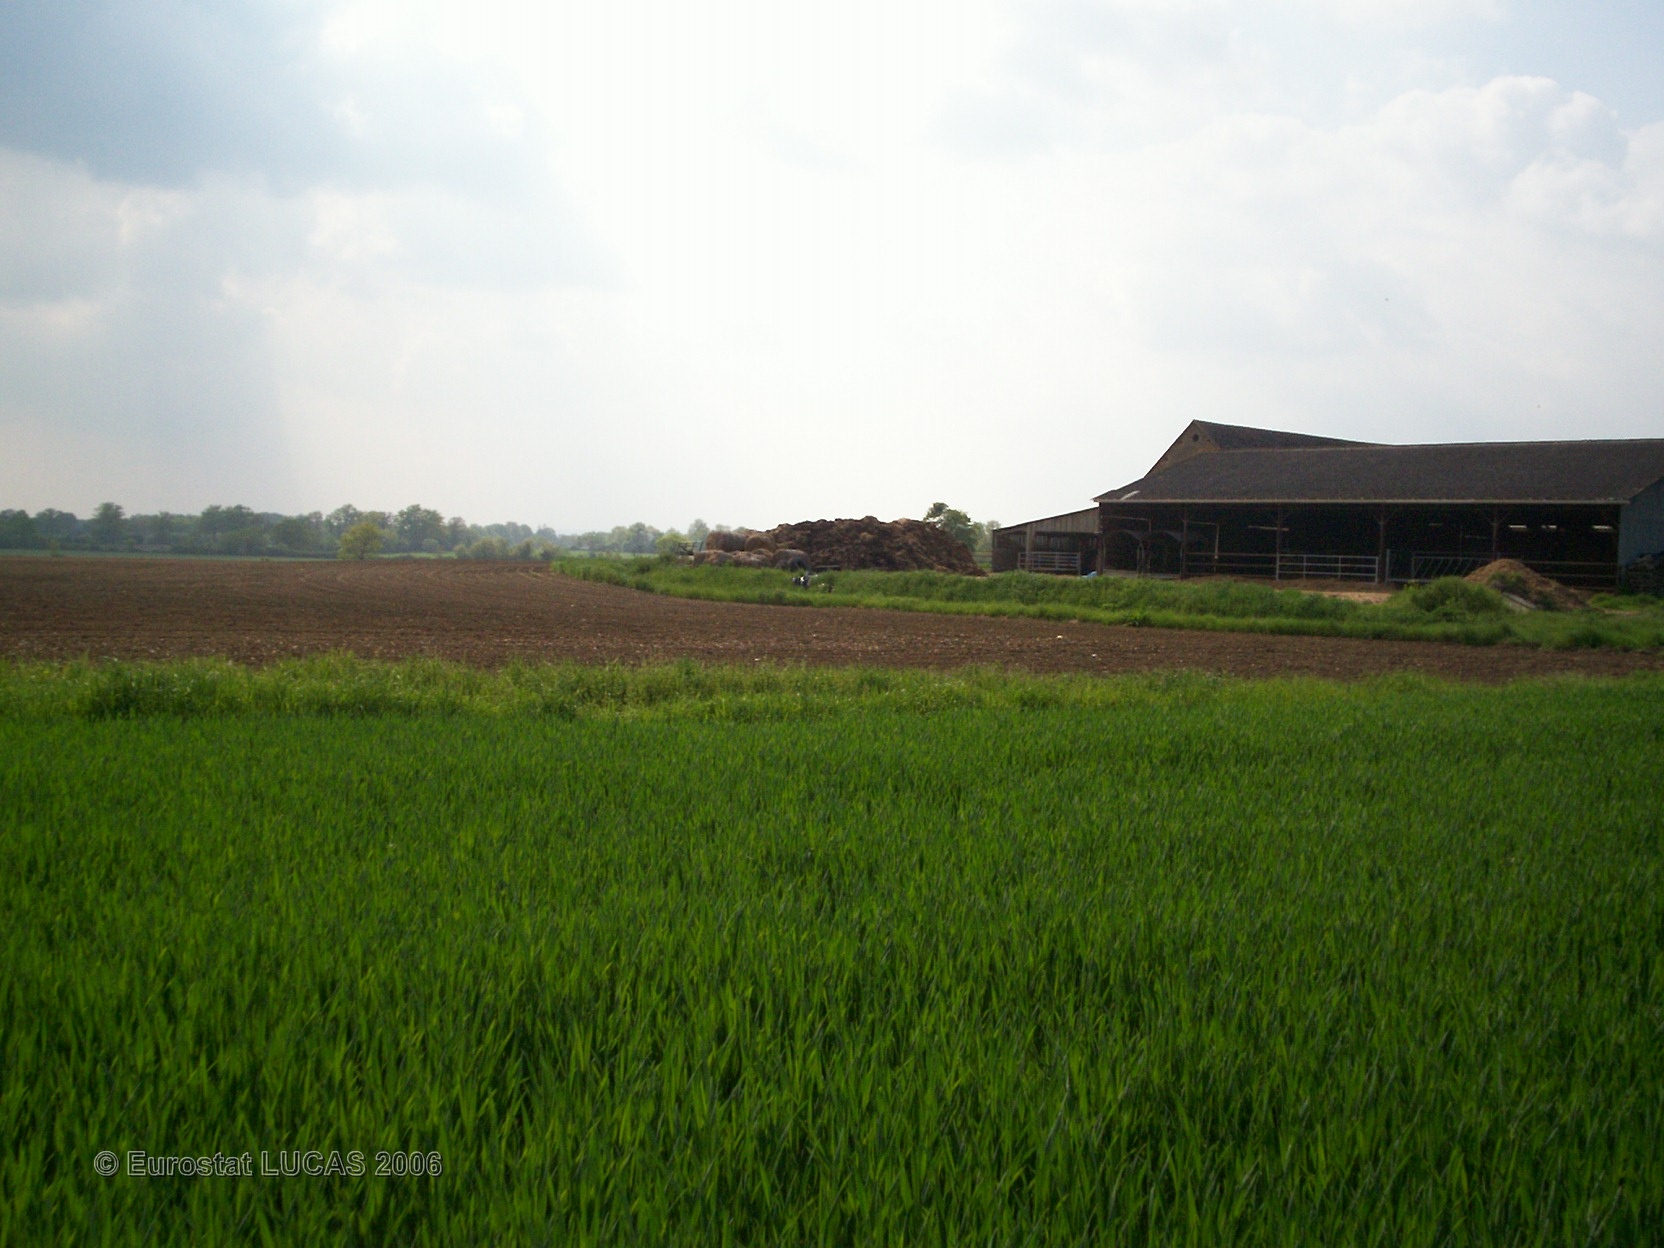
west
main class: Cropland
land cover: Common wheat
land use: Agriculture (excluding fallow land and kitchen gardens)
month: May
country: FR
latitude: 48.5191
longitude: 0.2930
